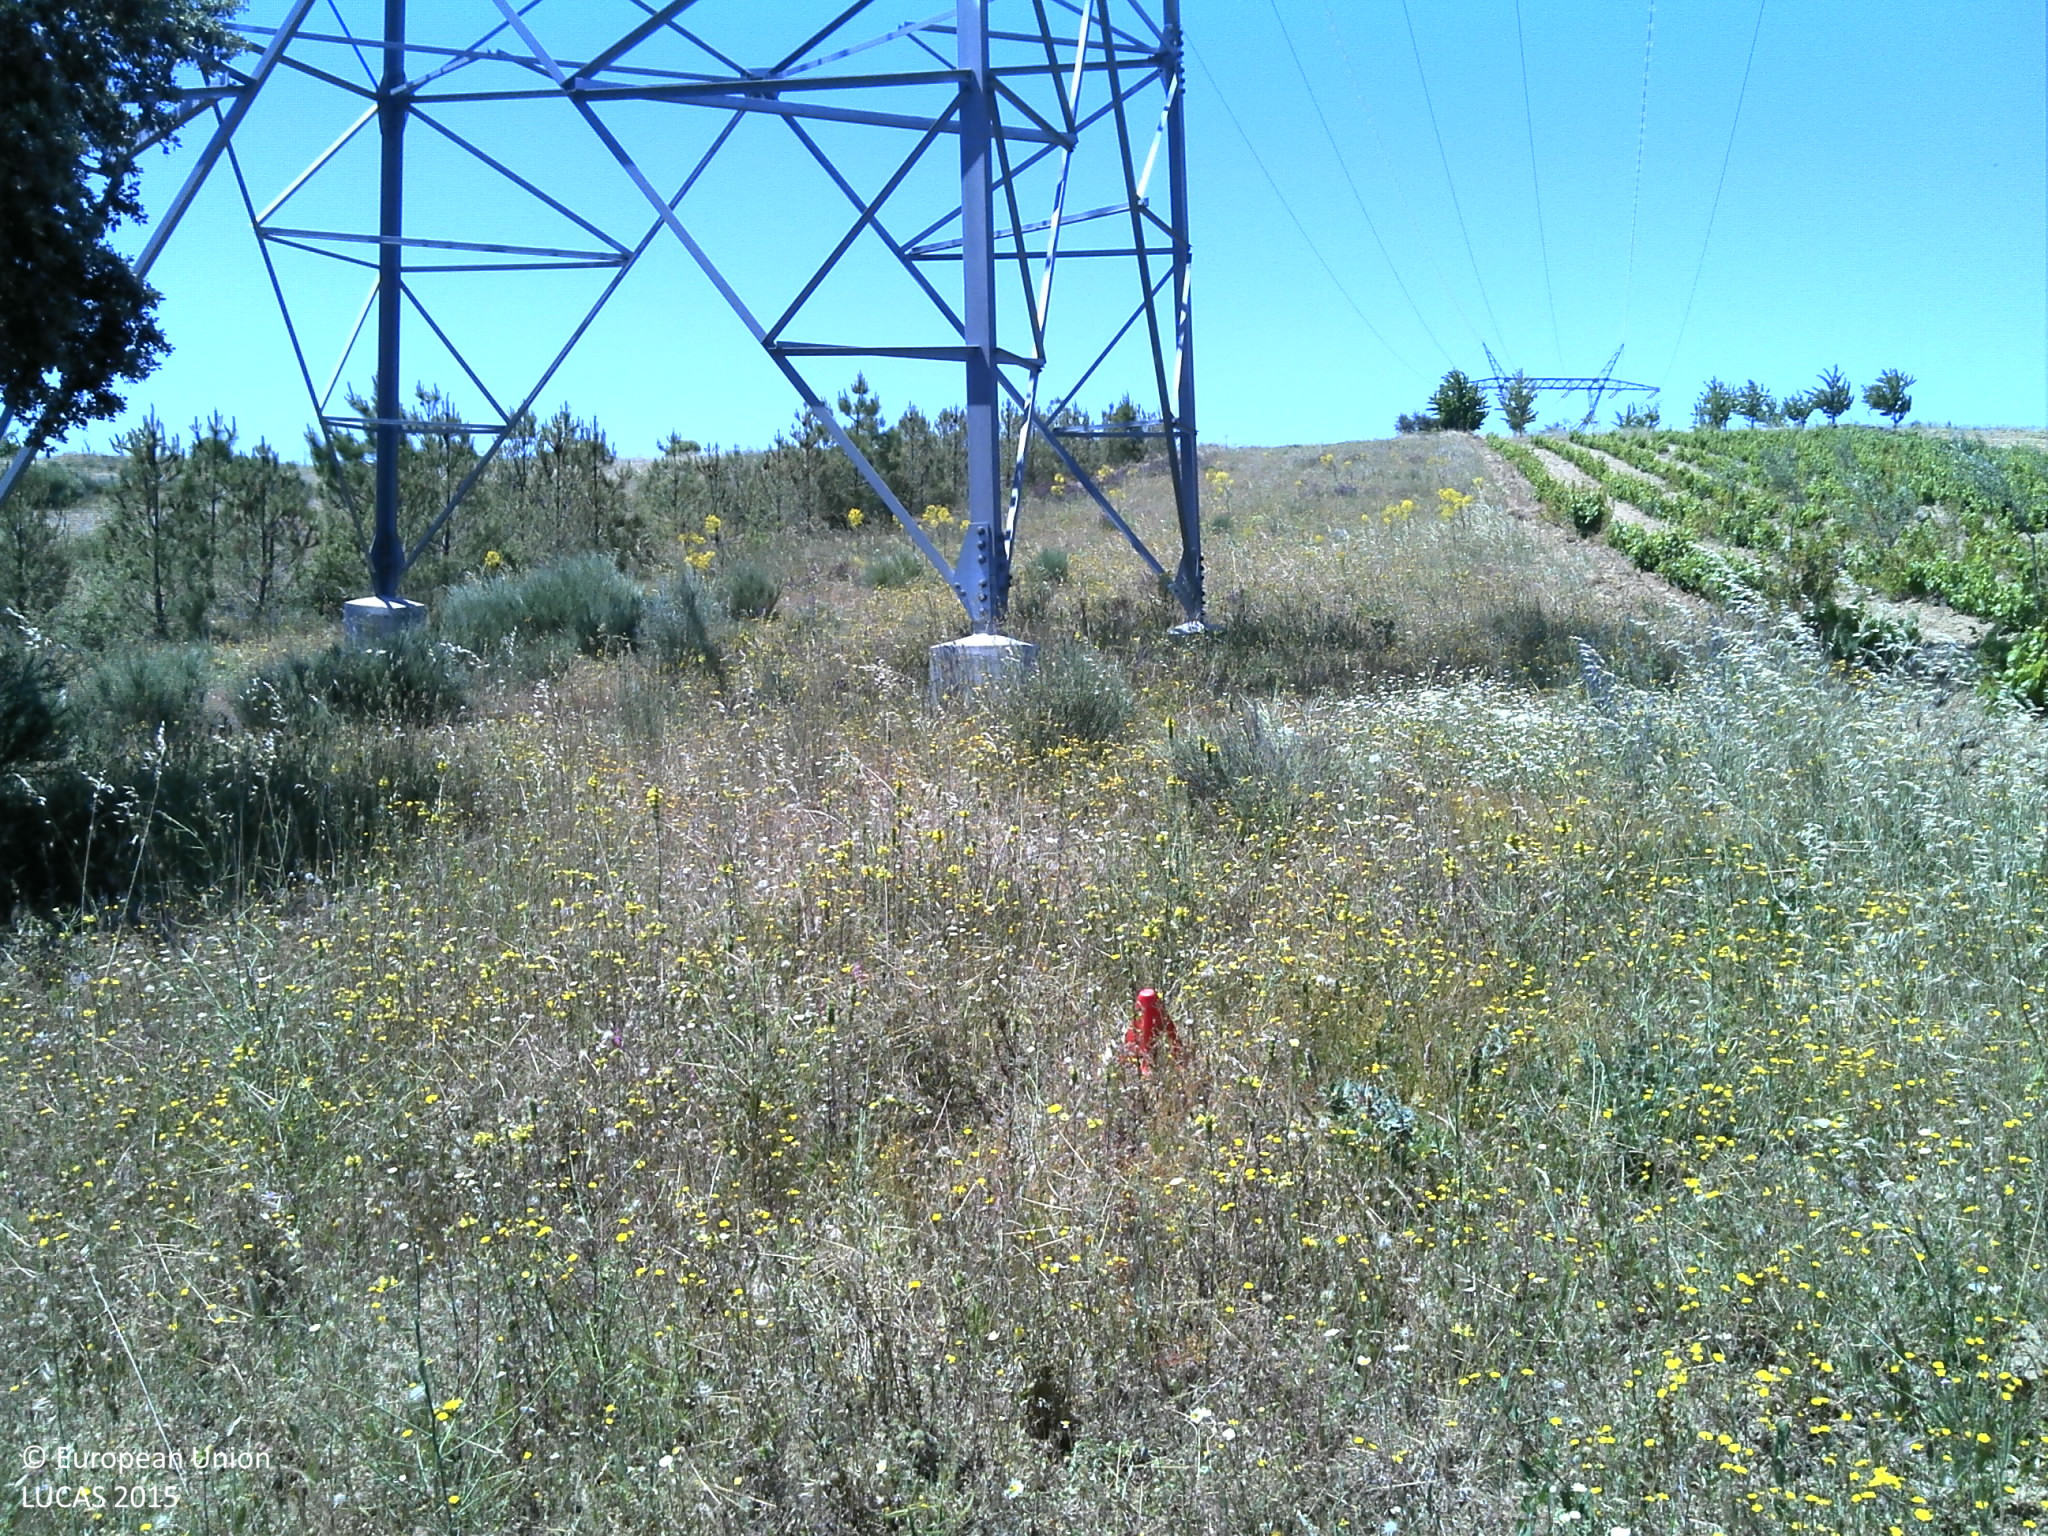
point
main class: Artificial land
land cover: Other artificial areas
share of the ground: 25 - 50 %
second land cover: Grassland without tree/shrub cover
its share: 50 - 75 %
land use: Electricity, gas and thermal power distribution
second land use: Agriculture (excluding fallow land and kitchen gardens)
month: May
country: PT
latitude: 41.4061
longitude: -6.3547
